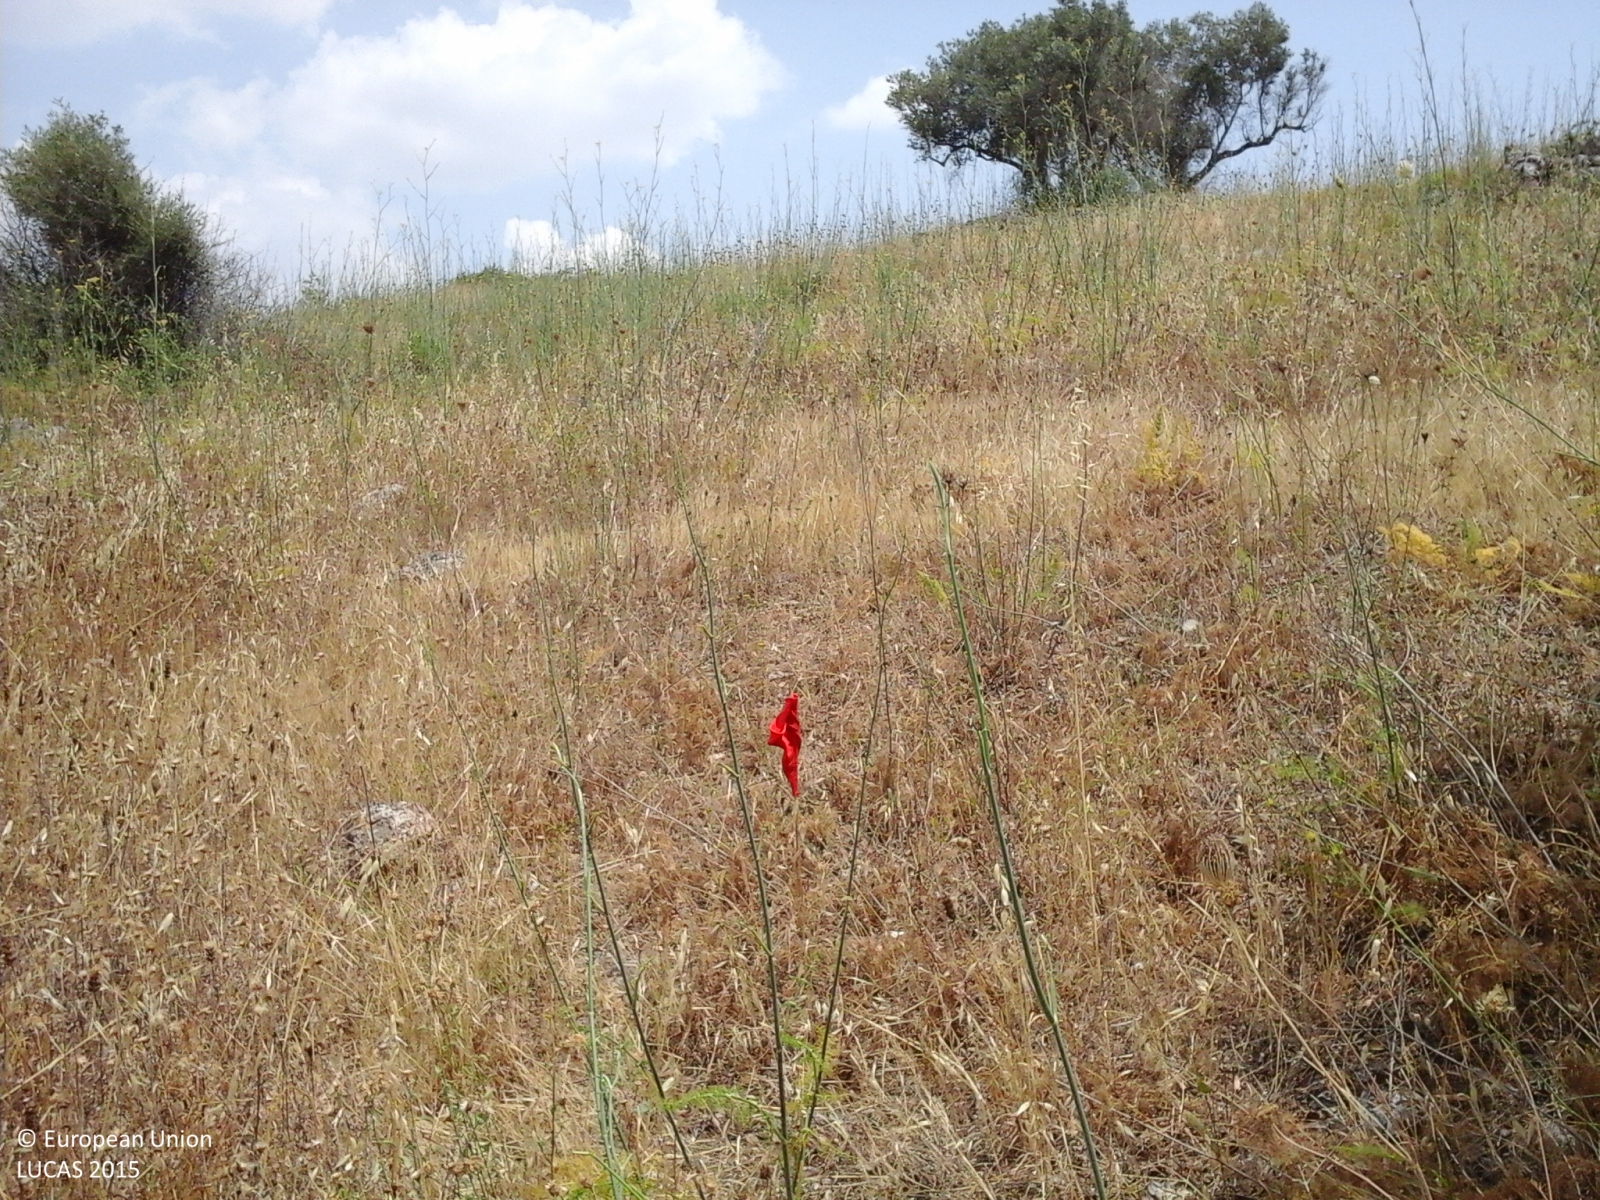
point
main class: Grassland
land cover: Grassland with sparse tree/shrub cover
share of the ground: > 75 %
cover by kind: herbaceous plants 85 %, shrubs 10 %, coniferous forest trees 5 %
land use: Semi-natural and natural areas not in use
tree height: > 5 m
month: July
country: IT
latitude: 37.2837
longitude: 13.9509
